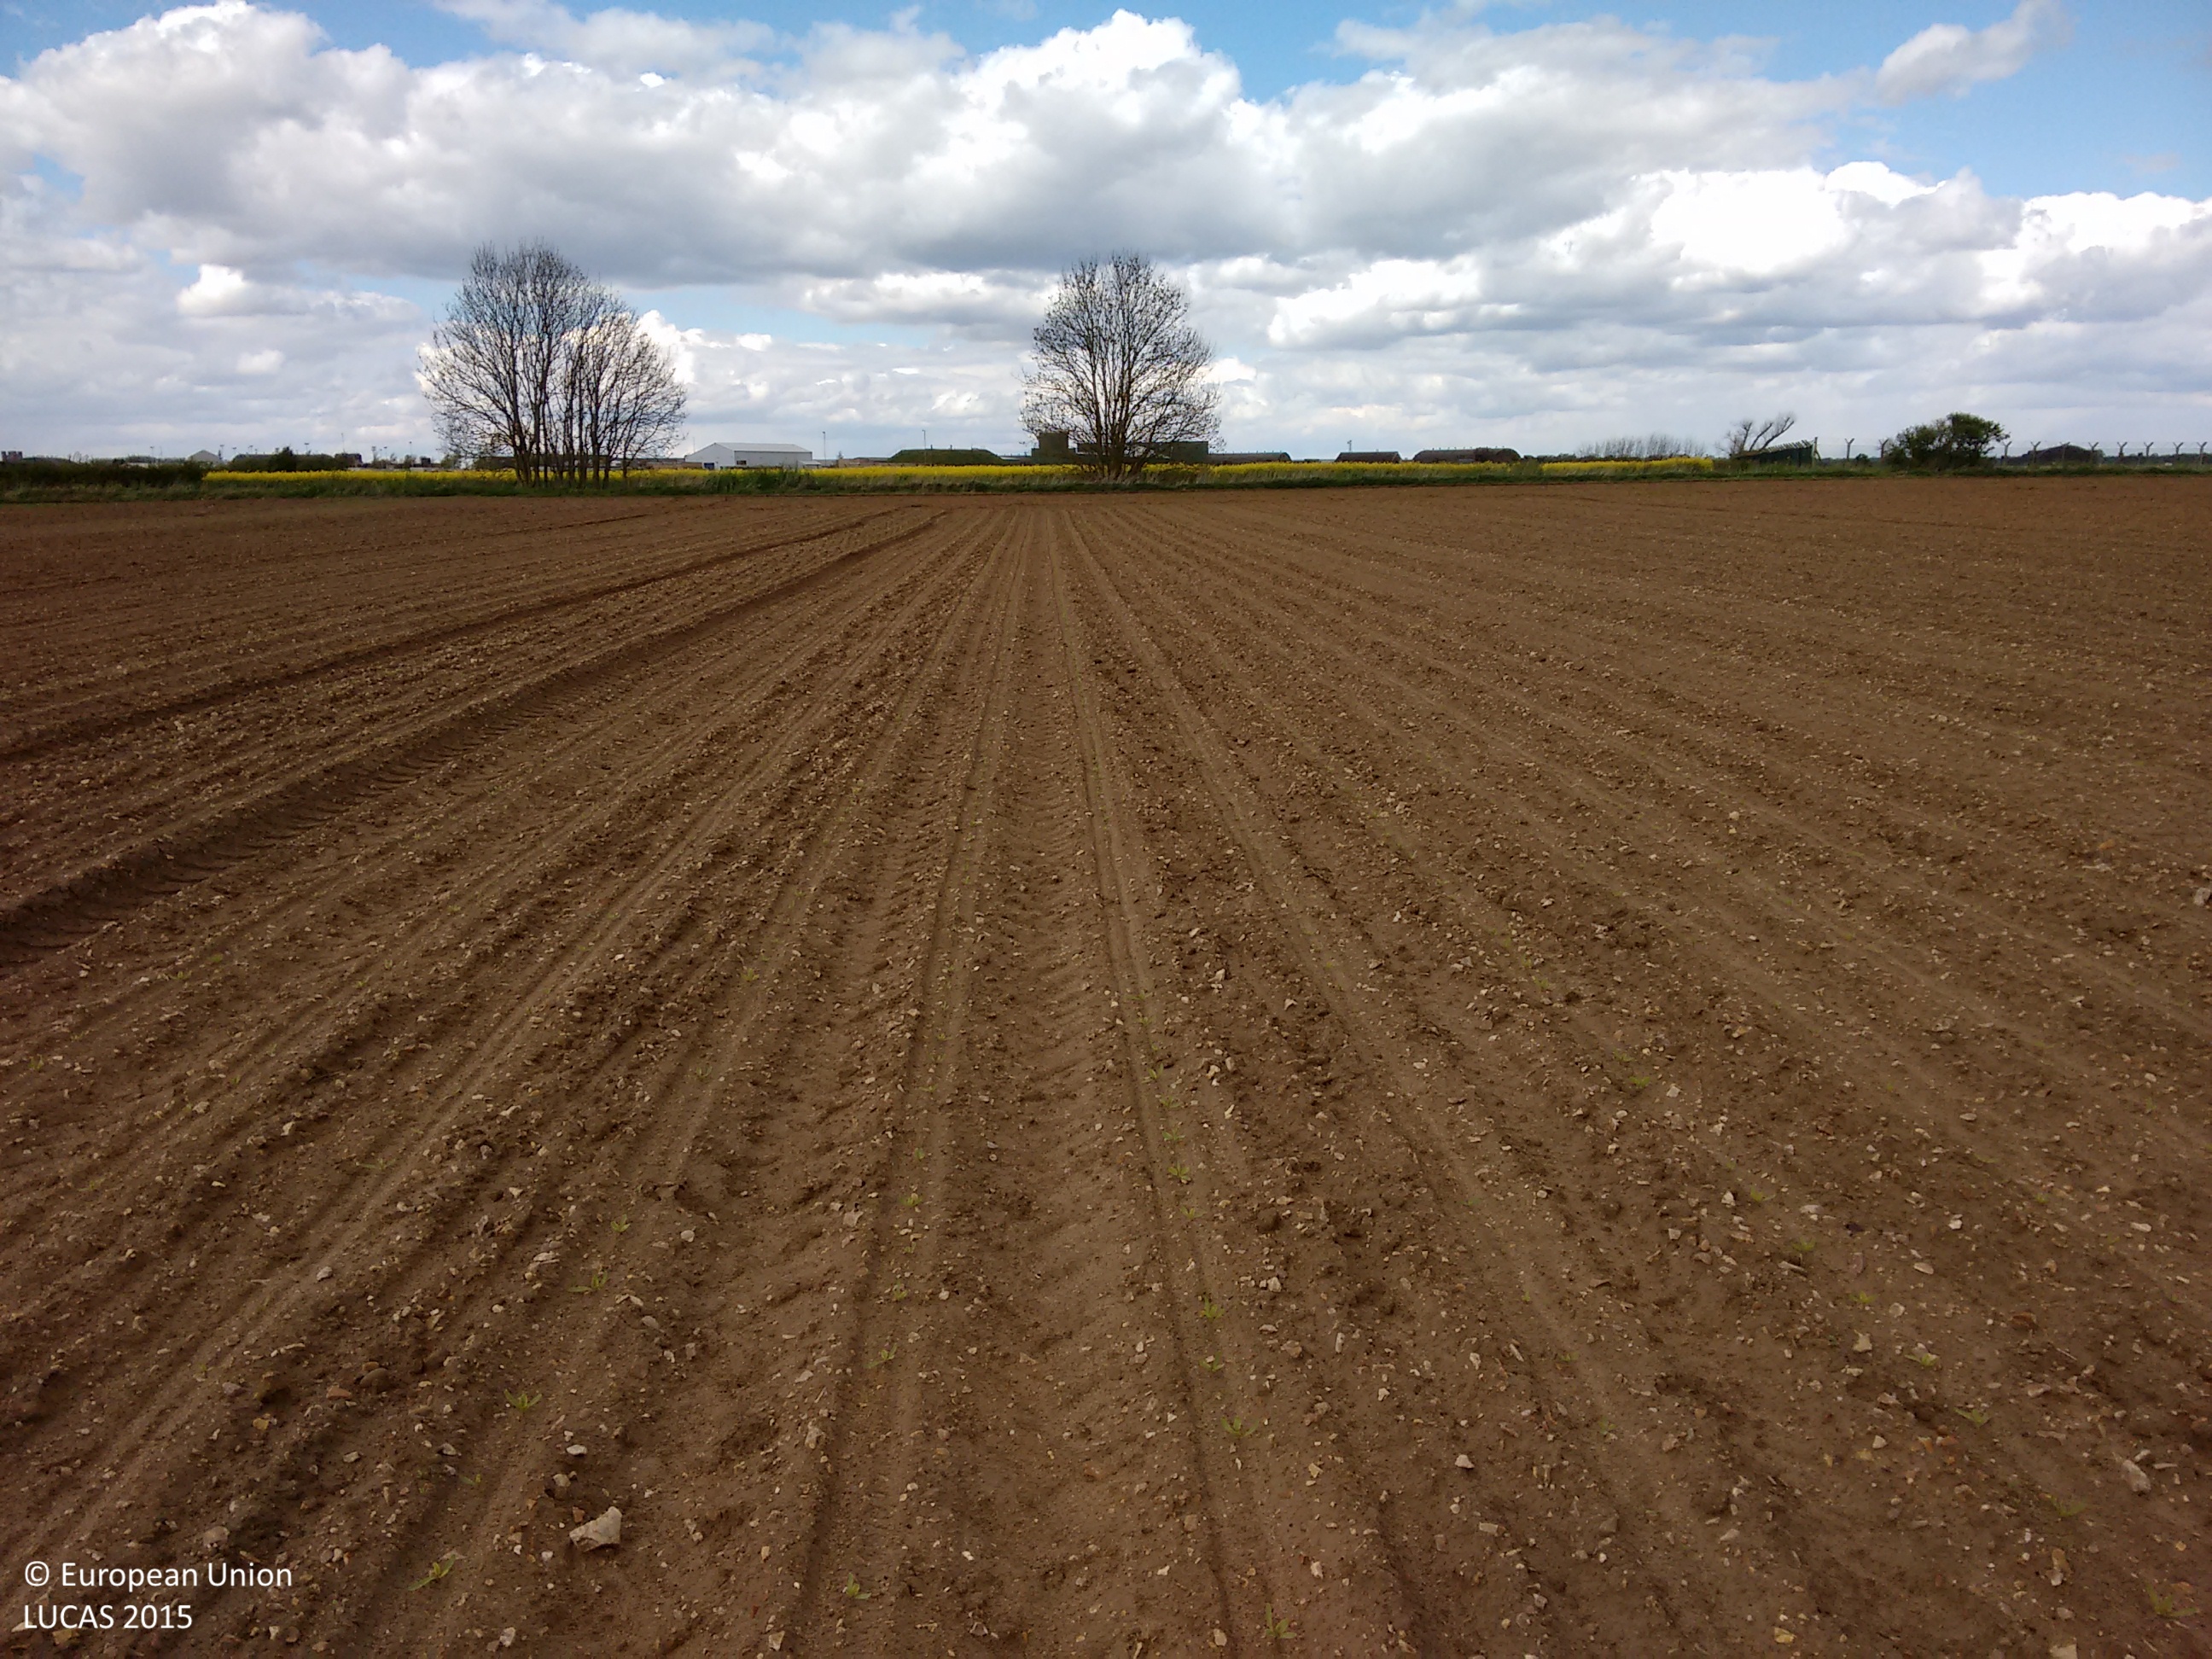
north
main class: Cropland
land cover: Other fresh vegetables
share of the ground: < 10 %
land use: Agriculture (excluding fallow land and kitchen gardens)
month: April
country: GB
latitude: 53.0814
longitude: -0.1705
